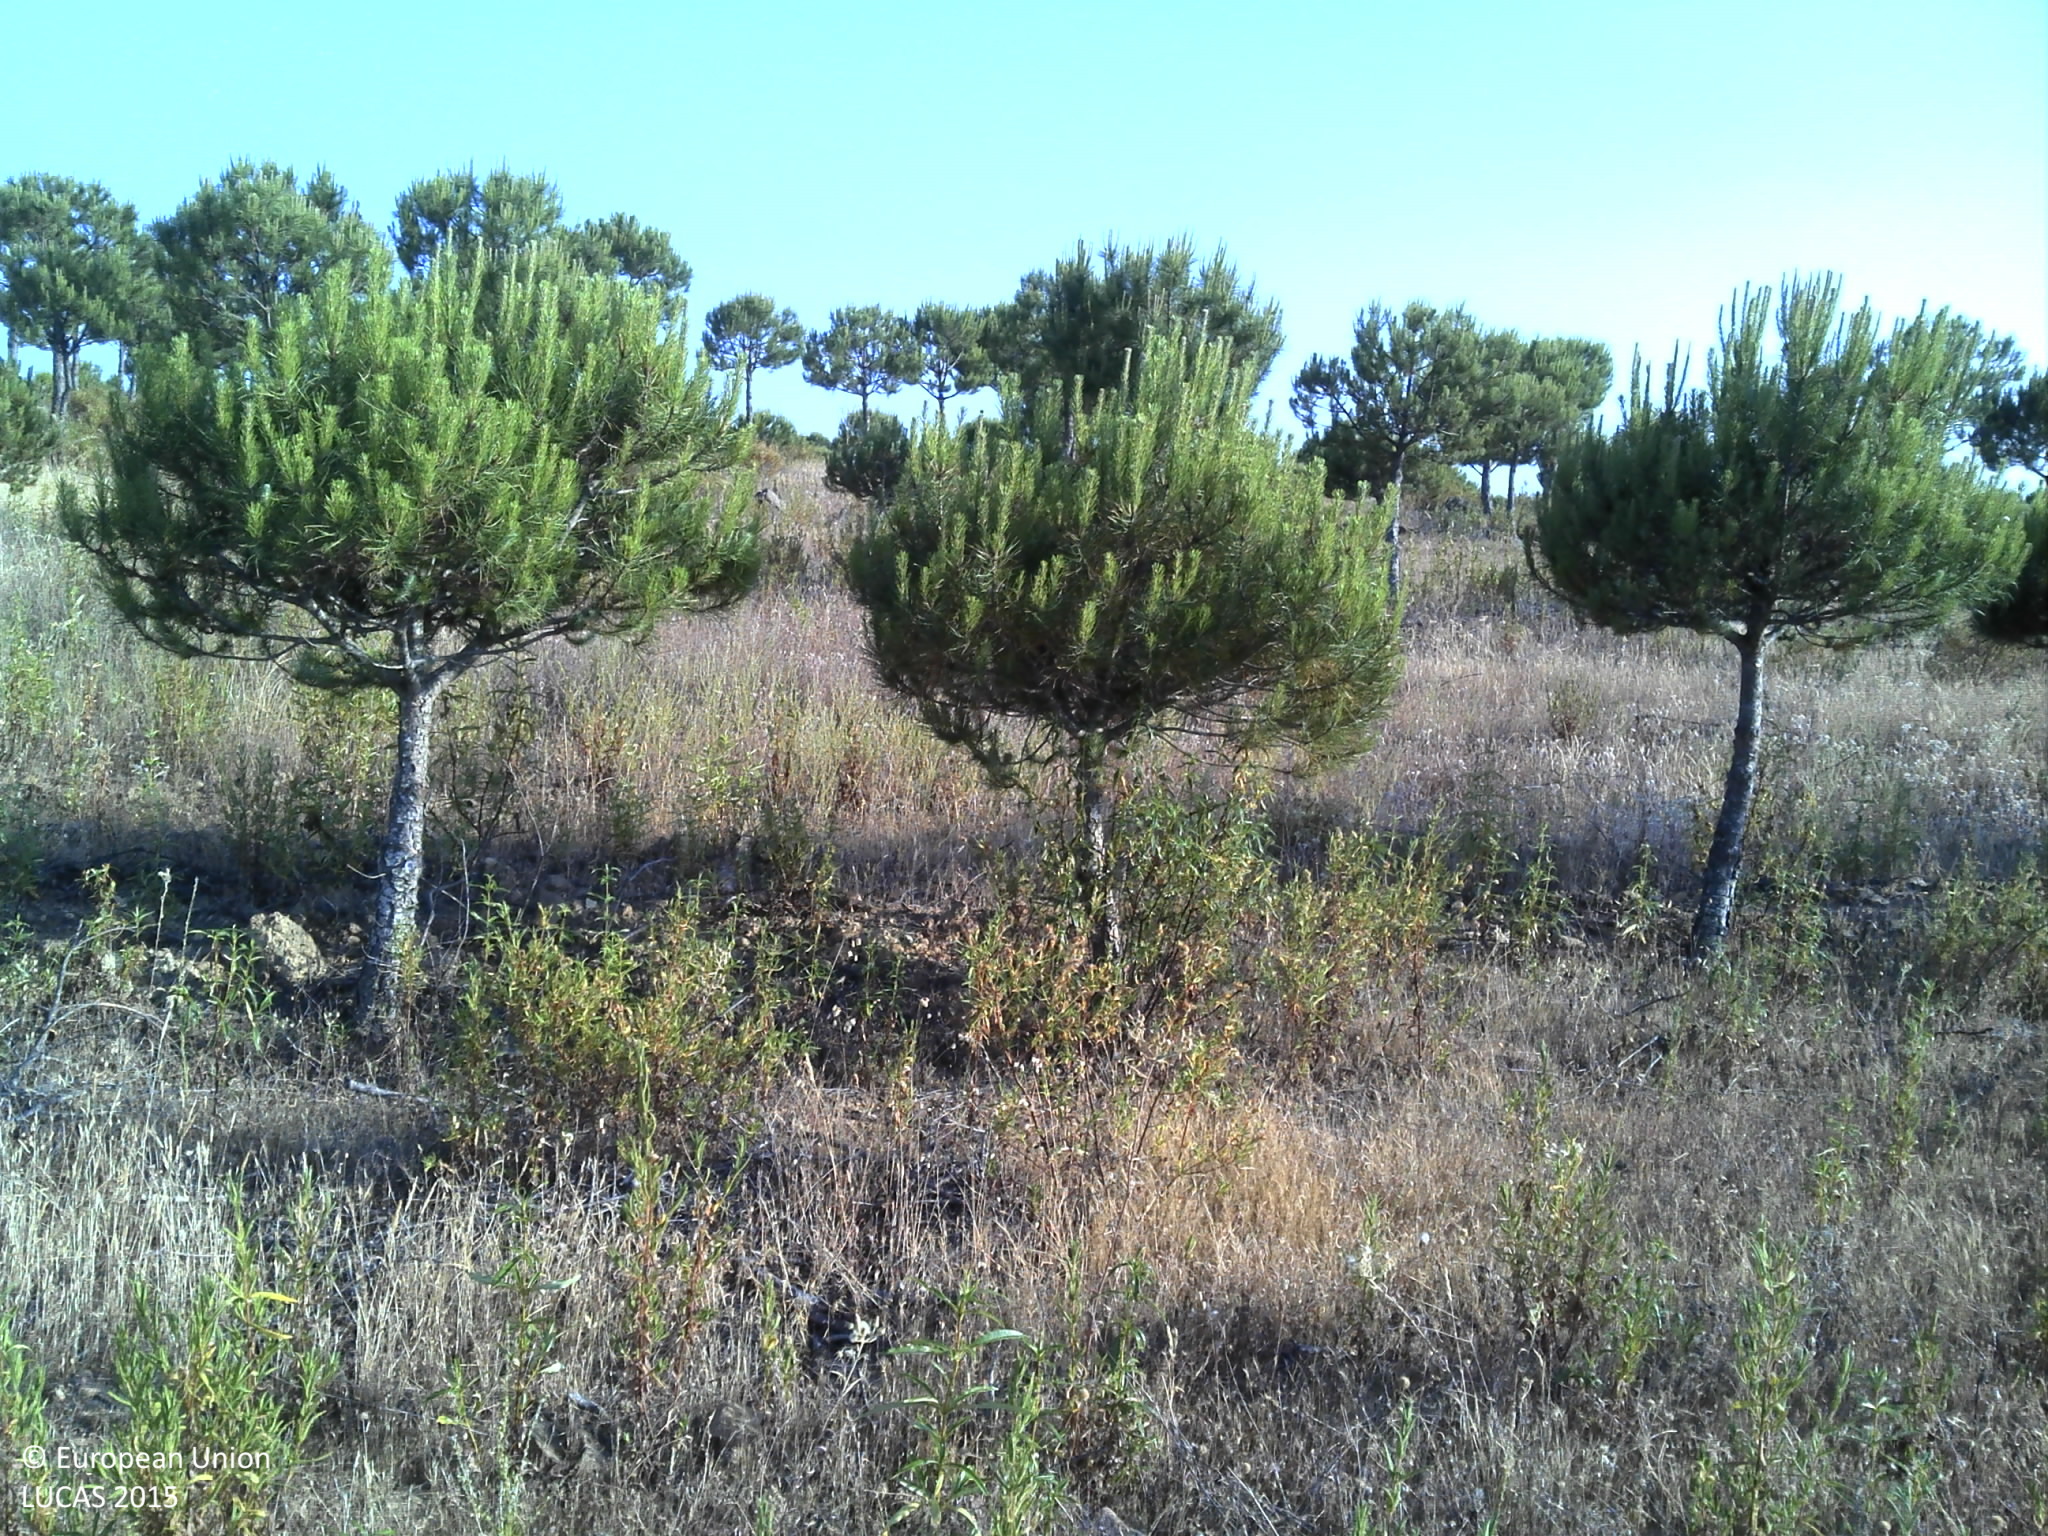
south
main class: Woodland
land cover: Pine dominated coniferous woodland
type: coniferous forest of the mediterranean region
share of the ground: 10 - 25 %
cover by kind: herbaceous plants 50 %, coniferous forest trees 25 %, shrubs 25 %
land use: Forestry
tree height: < 5 m
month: May
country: PT
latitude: 37.4334
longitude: -7.7453
